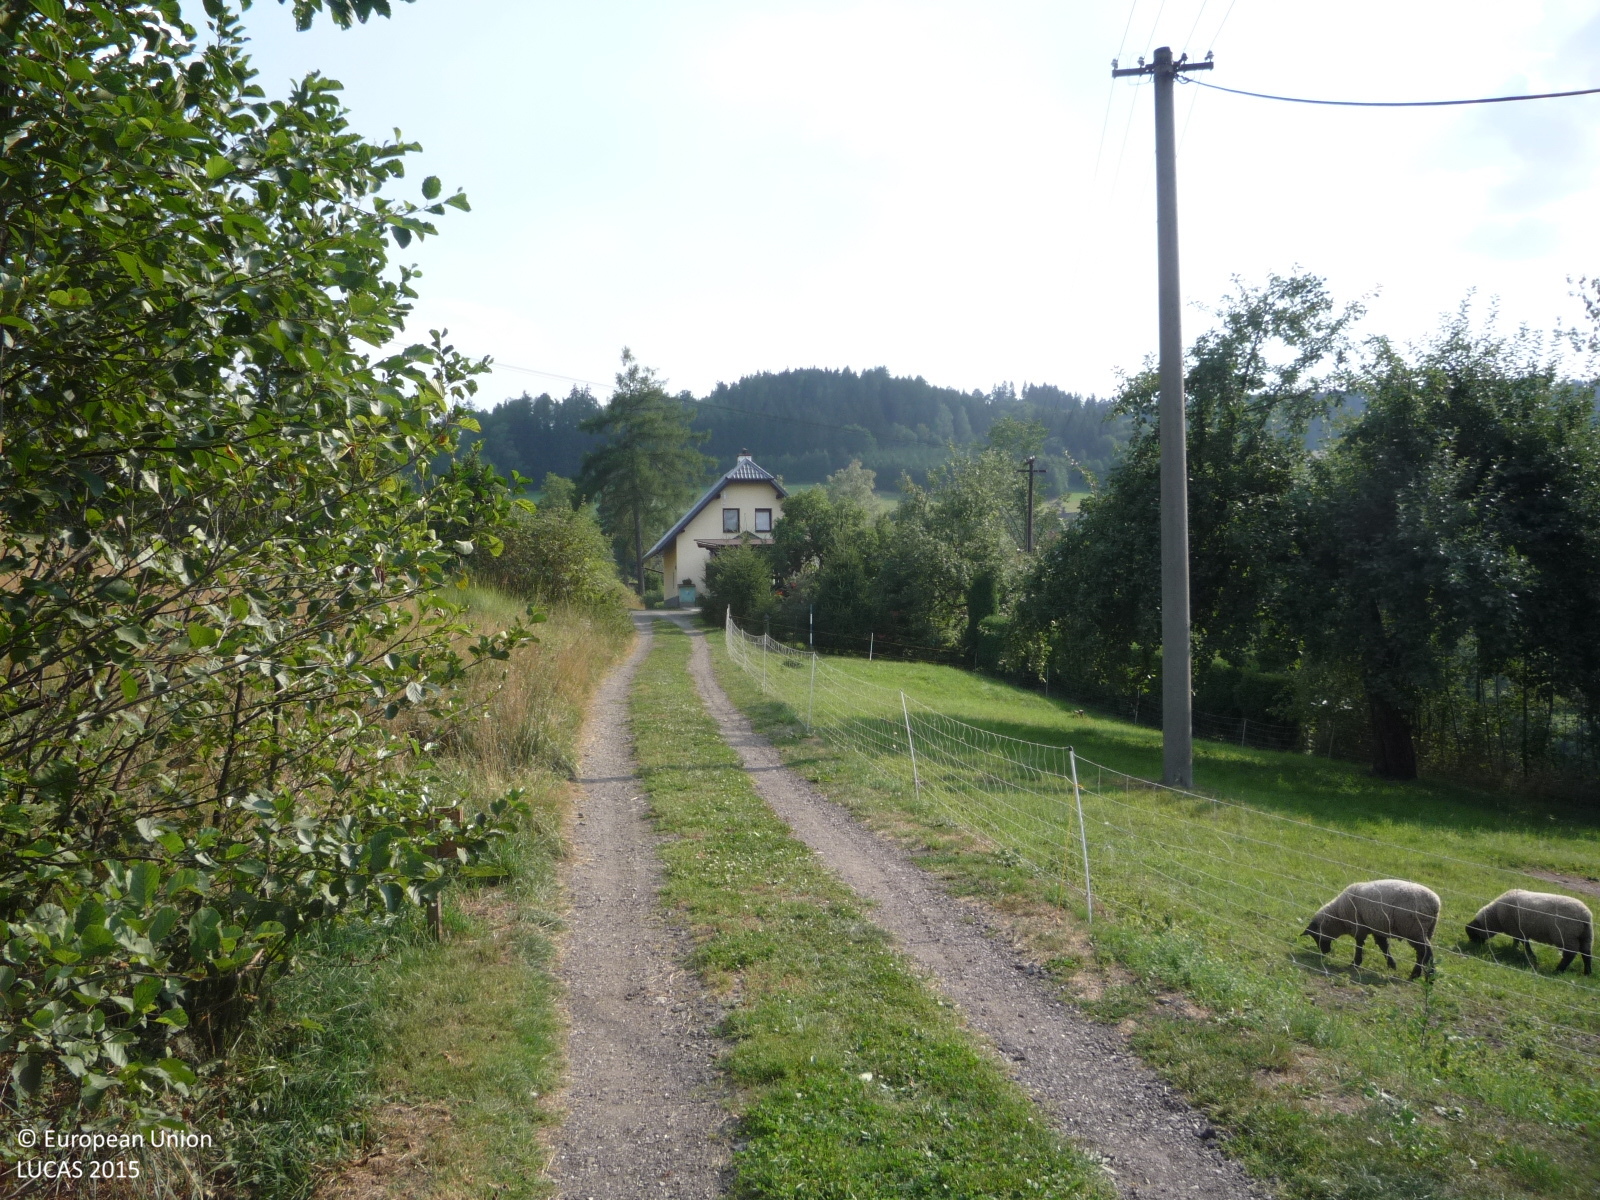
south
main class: Grassland
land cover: Grassland with sparse tree/shrub cover
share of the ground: > 75 %
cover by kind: herbaceous plants 90 %, broadleaved forest trees 5 %, shrubs 5 %
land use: Semi-natural and natural areas not in use
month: August
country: CZ
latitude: 50.6016
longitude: 15.3019
